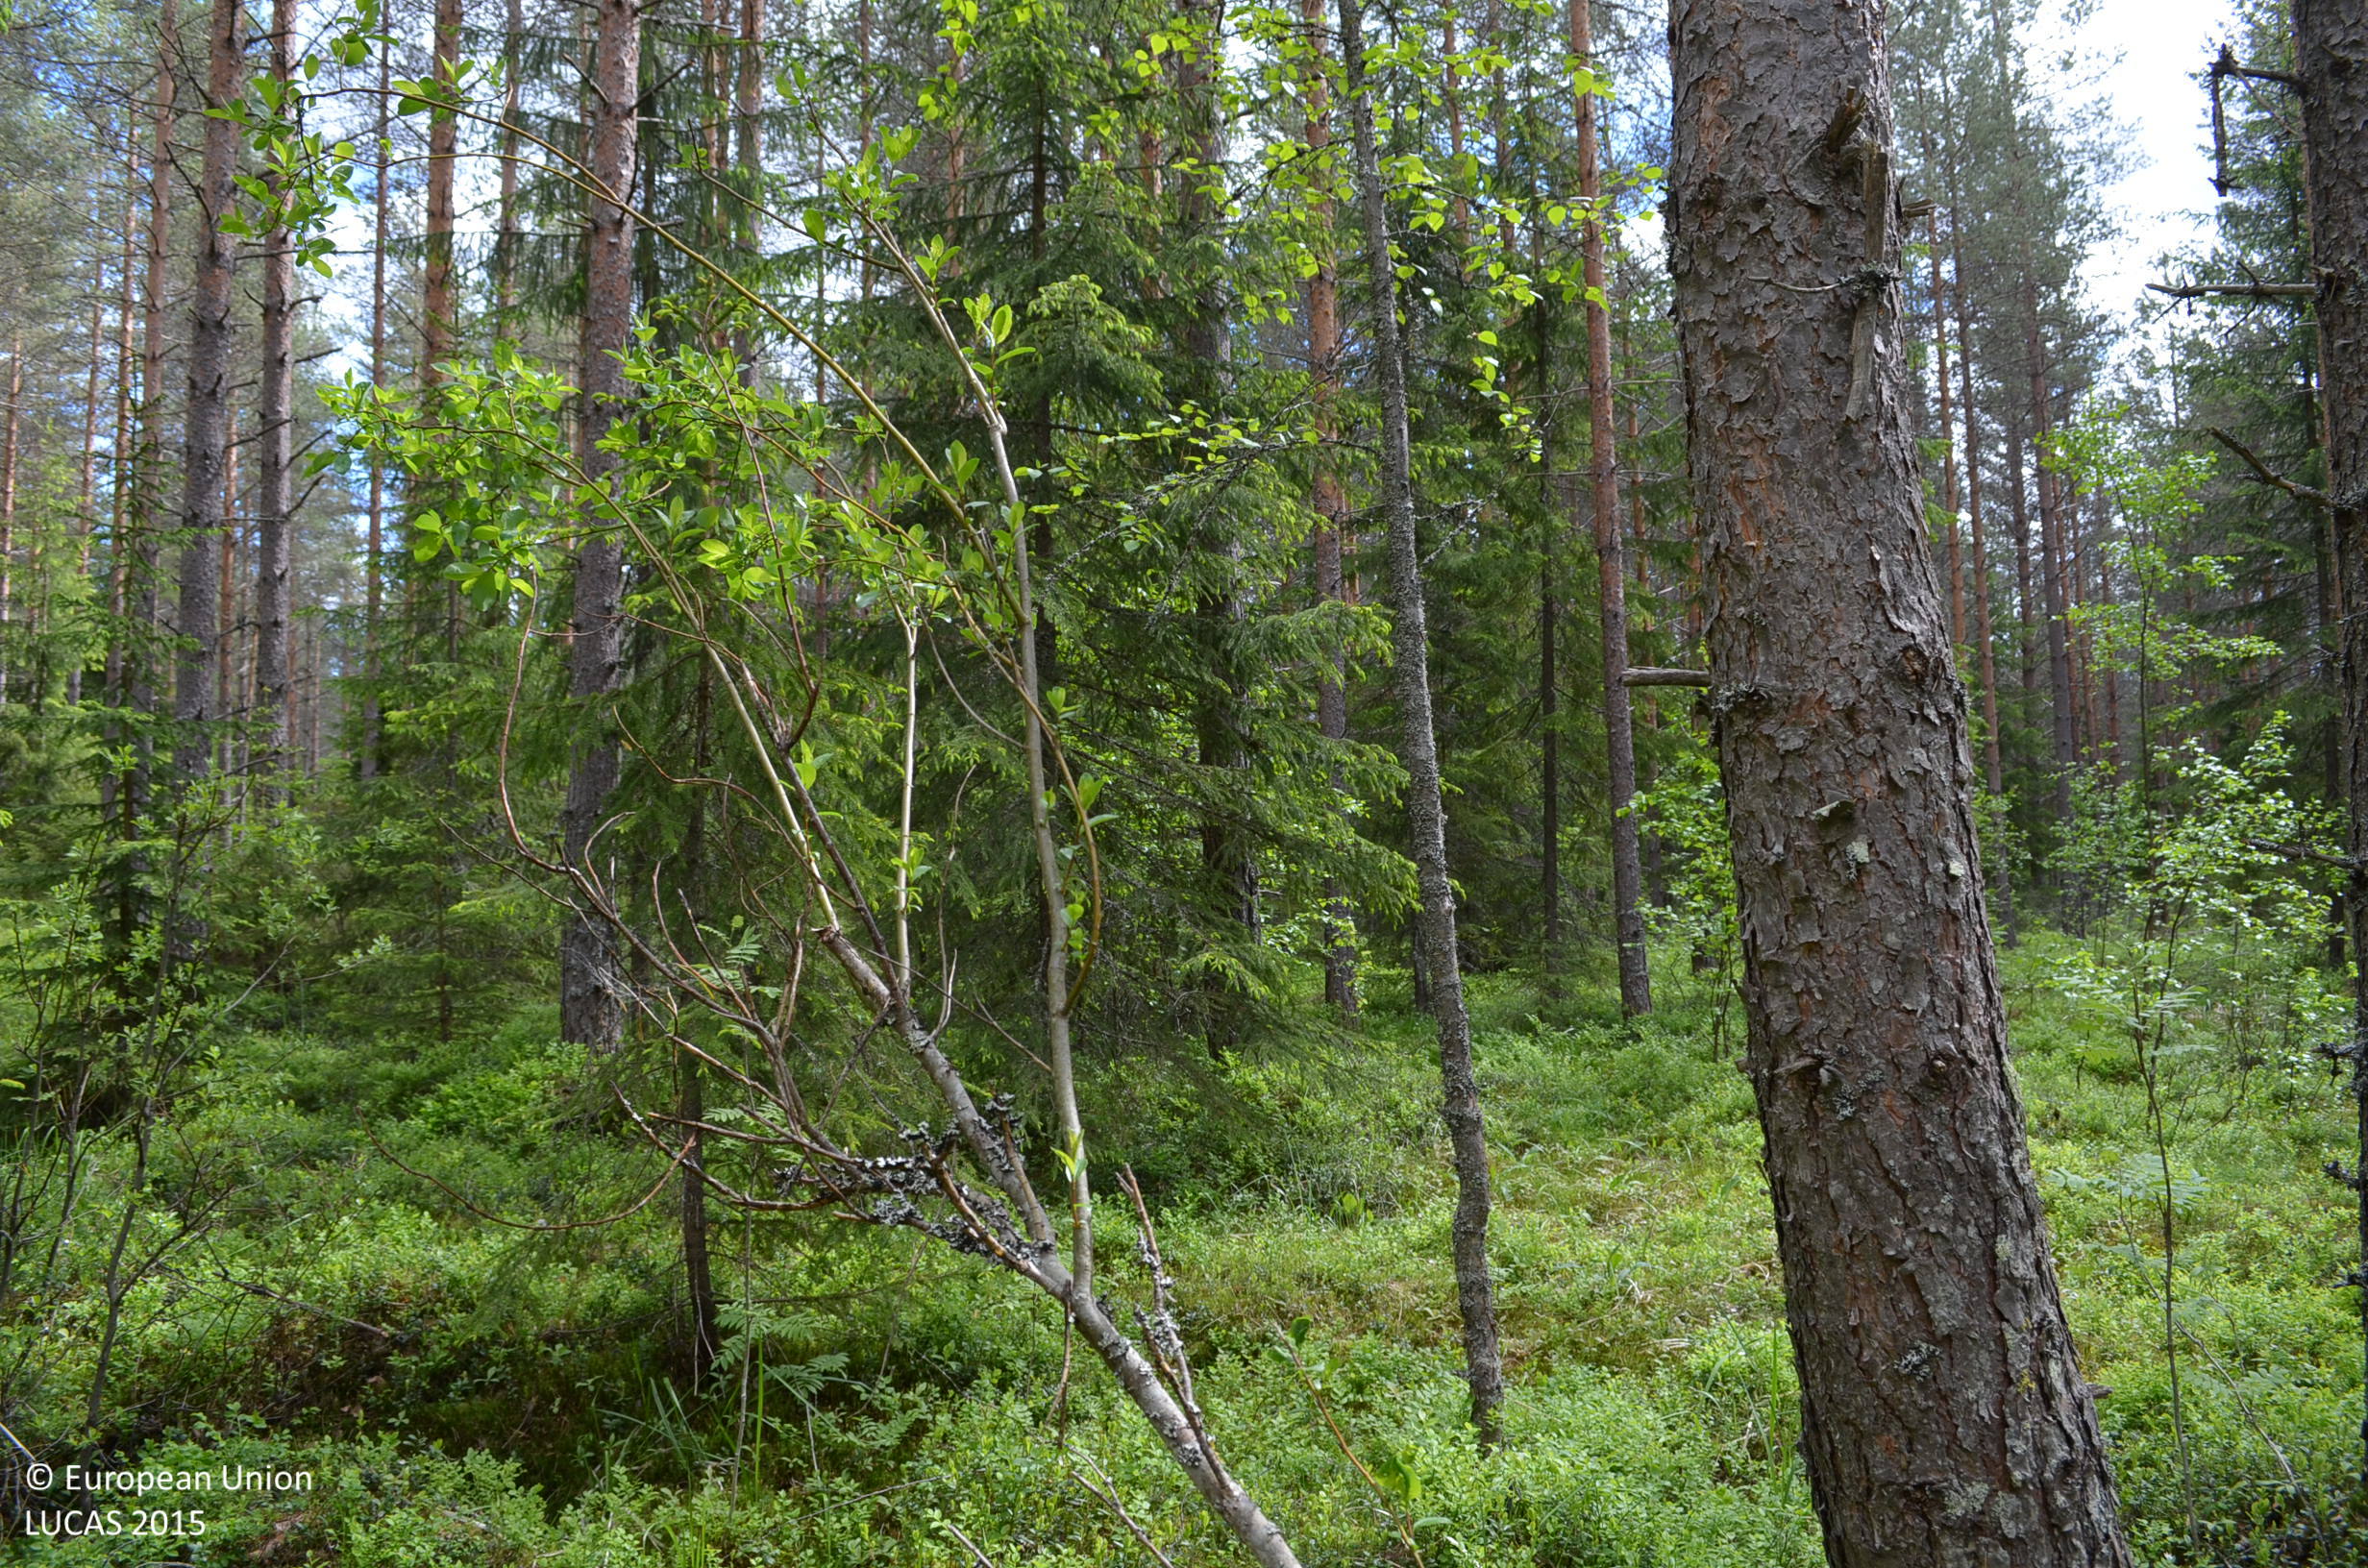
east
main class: Woodland
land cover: Other coniferous woodland
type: boreal forest
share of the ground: > 75 %
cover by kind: coniferous forest trees 75 %, herbaceous plants 20 %, broadleaved forest trees 5 %
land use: Forestry
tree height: > 5 m
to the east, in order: Other coniferous woodland; Ditches and canals; Grass margins; Tracks; Grass margins; Ditches and canals; Pine dominated coniferous woodland; Spruce dominated mixed woodland; Ditches and canals; Pine dominated coniferous woodland
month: June
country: FI
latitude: 62.0037
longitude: 23.2668
